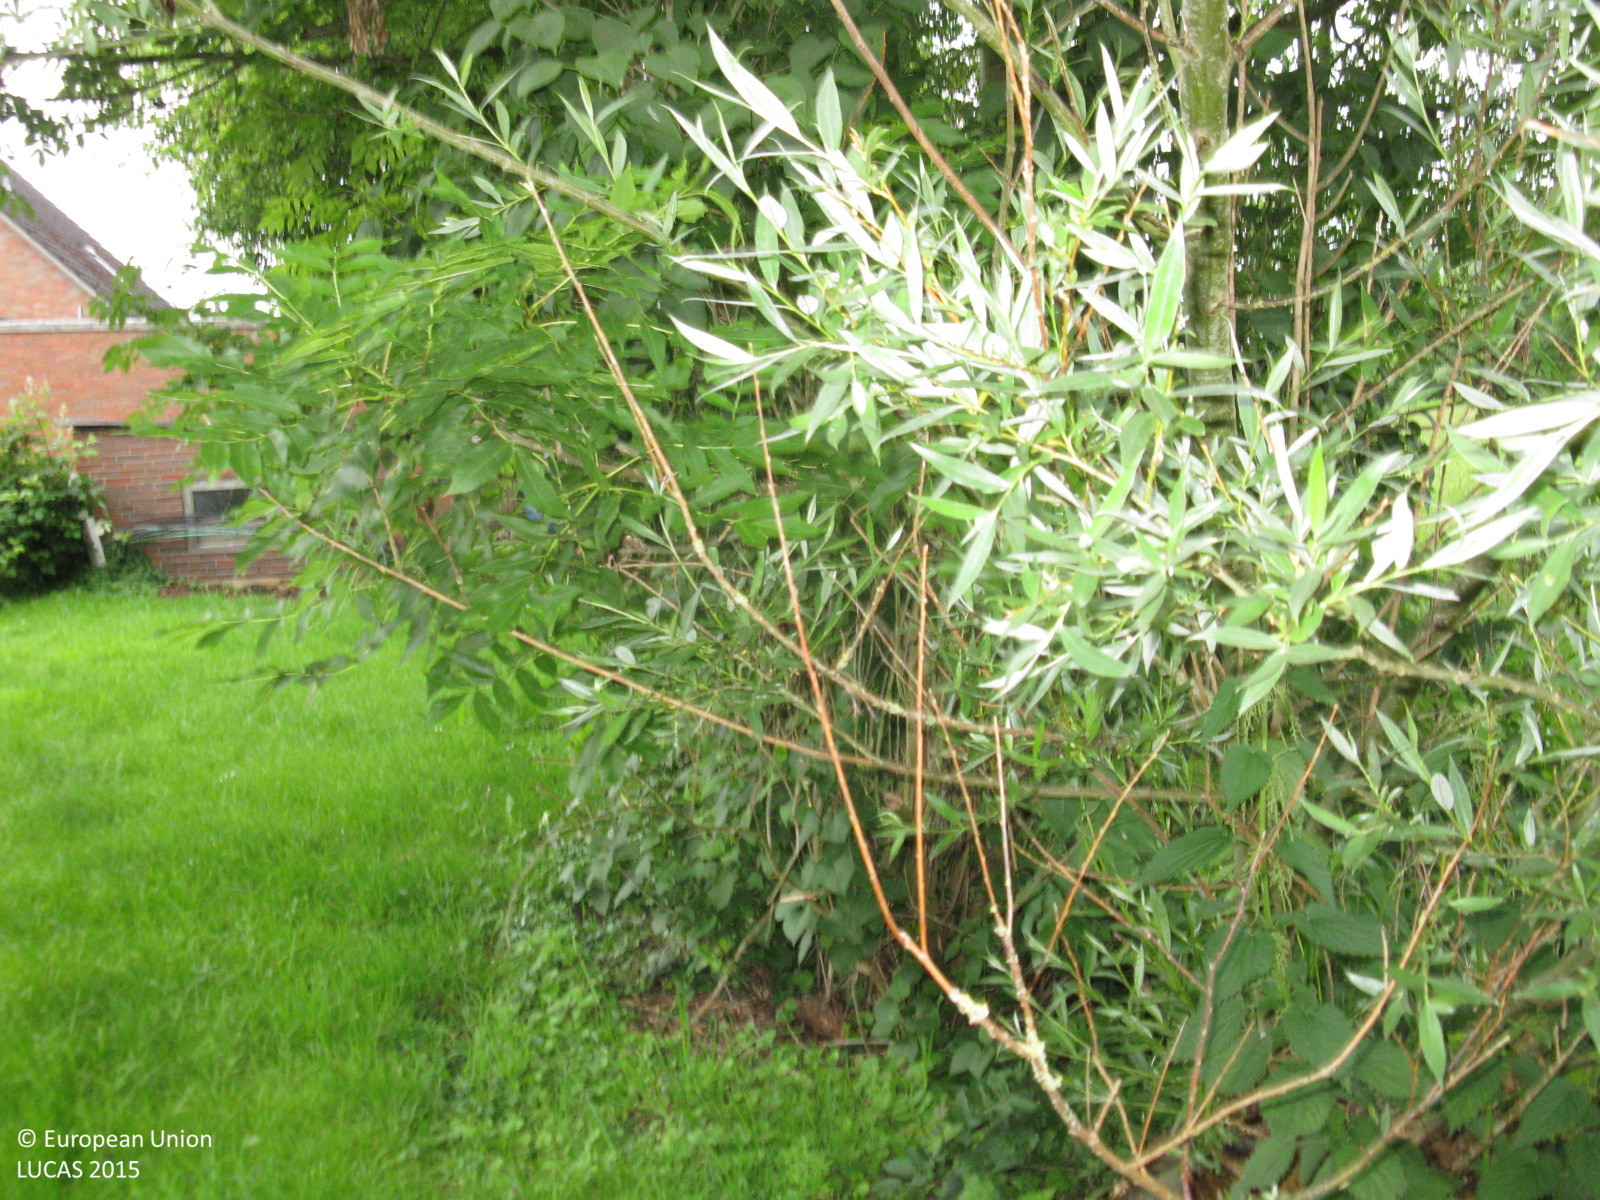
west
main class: Grassland
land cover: Grassland without tree/shrub cover
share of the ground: > 75 %
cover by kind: herbaceous plants 100 %
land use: Agriculture (excluding fallow land and kitchen gardens)
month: June
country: DE
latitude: 53.6359
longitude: 7.9288
